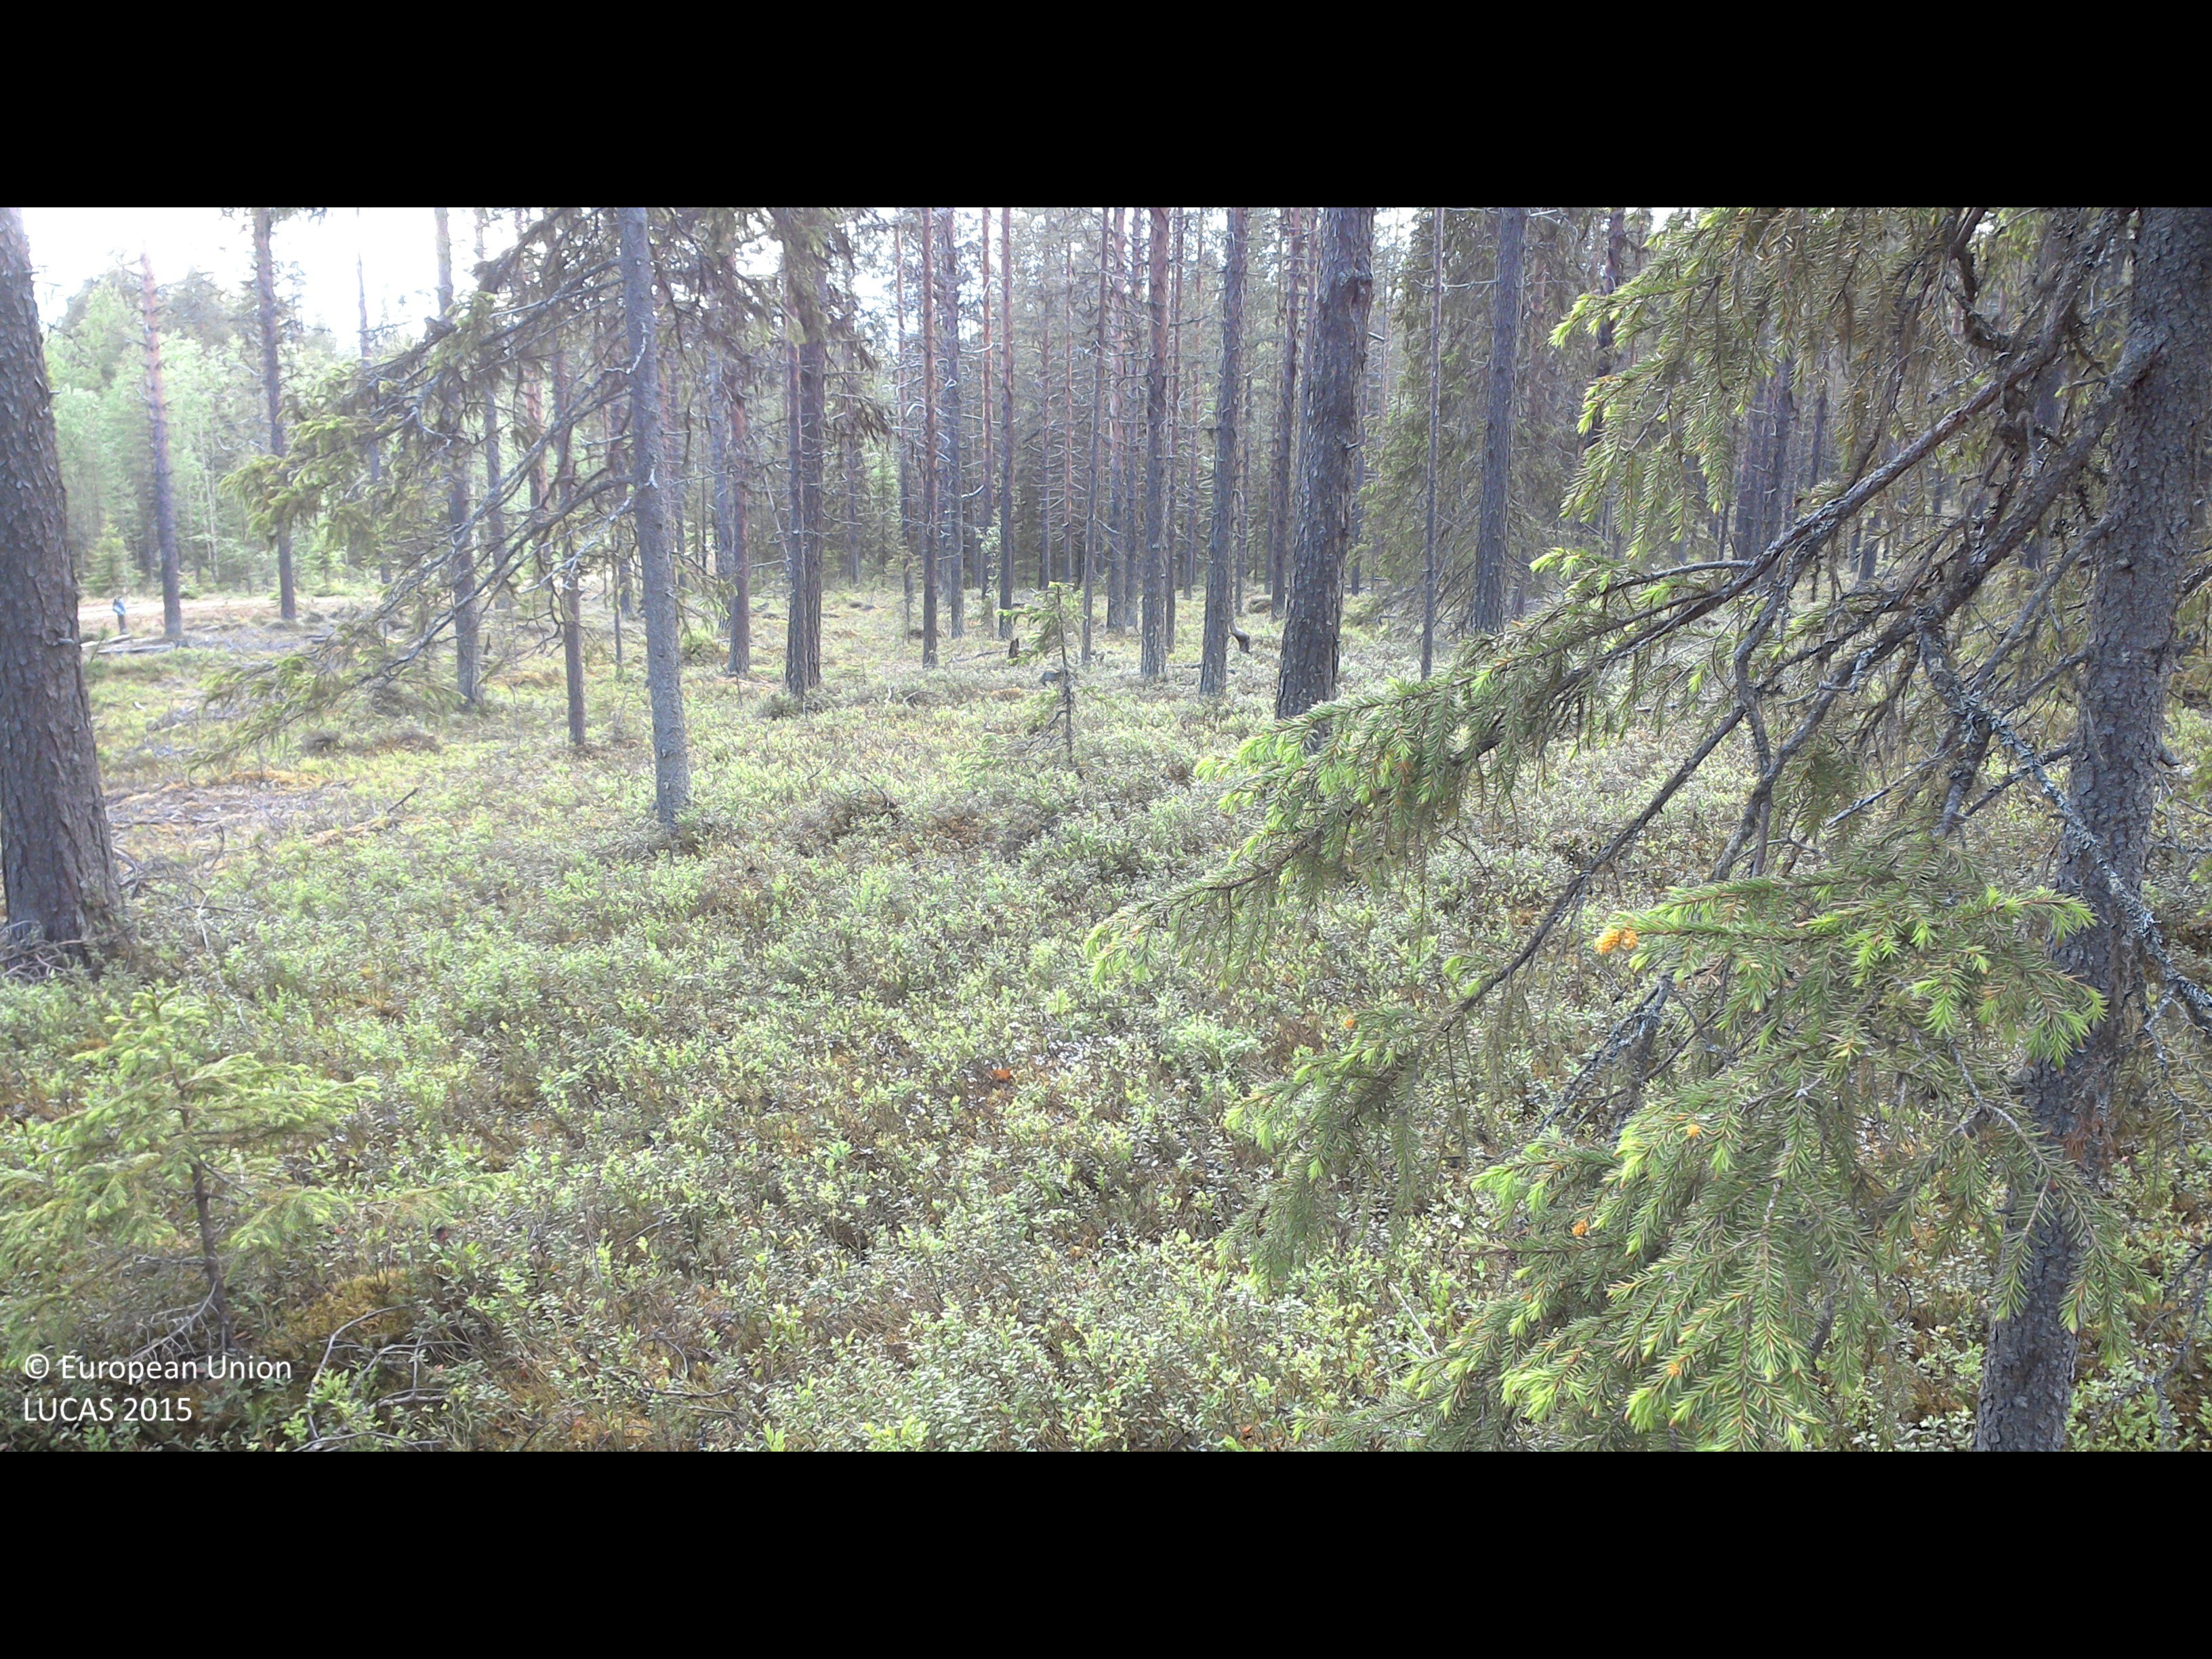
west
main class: Woodland
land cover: Pine dominated coniferous woodland
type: boreal forest
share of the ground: 25 - 50 %
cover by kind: shrubs 70 %, coniferous forest trees 25 %, lichens and mosses 5 %
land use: Forestry
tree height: > 5 m
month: June
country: SE
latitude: 67.0281
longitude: 22.4317
